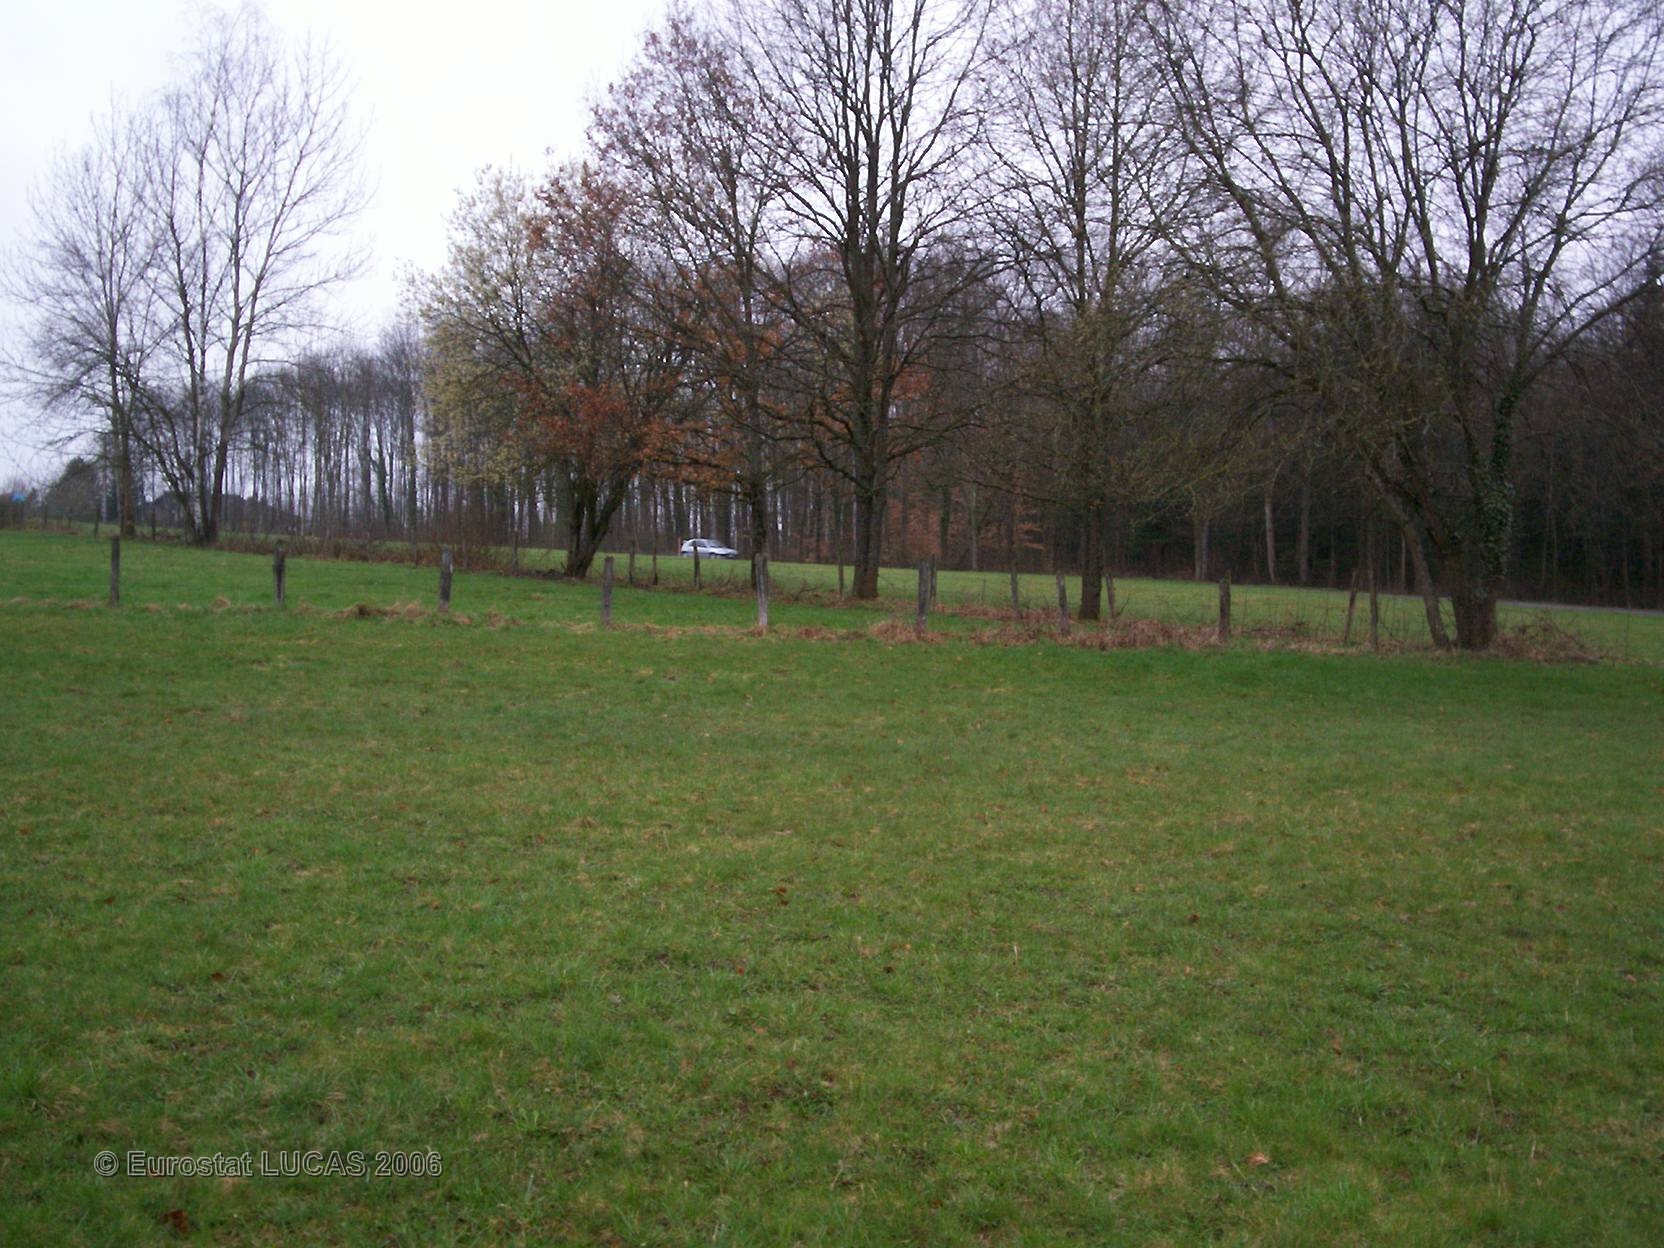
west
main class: Grassland
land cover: Grassland without tree/shrub cover
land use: Agriculture (excluding fallow land and kitchen gardens)
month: April
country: FR
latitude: 47.6186
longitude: 6.7950
